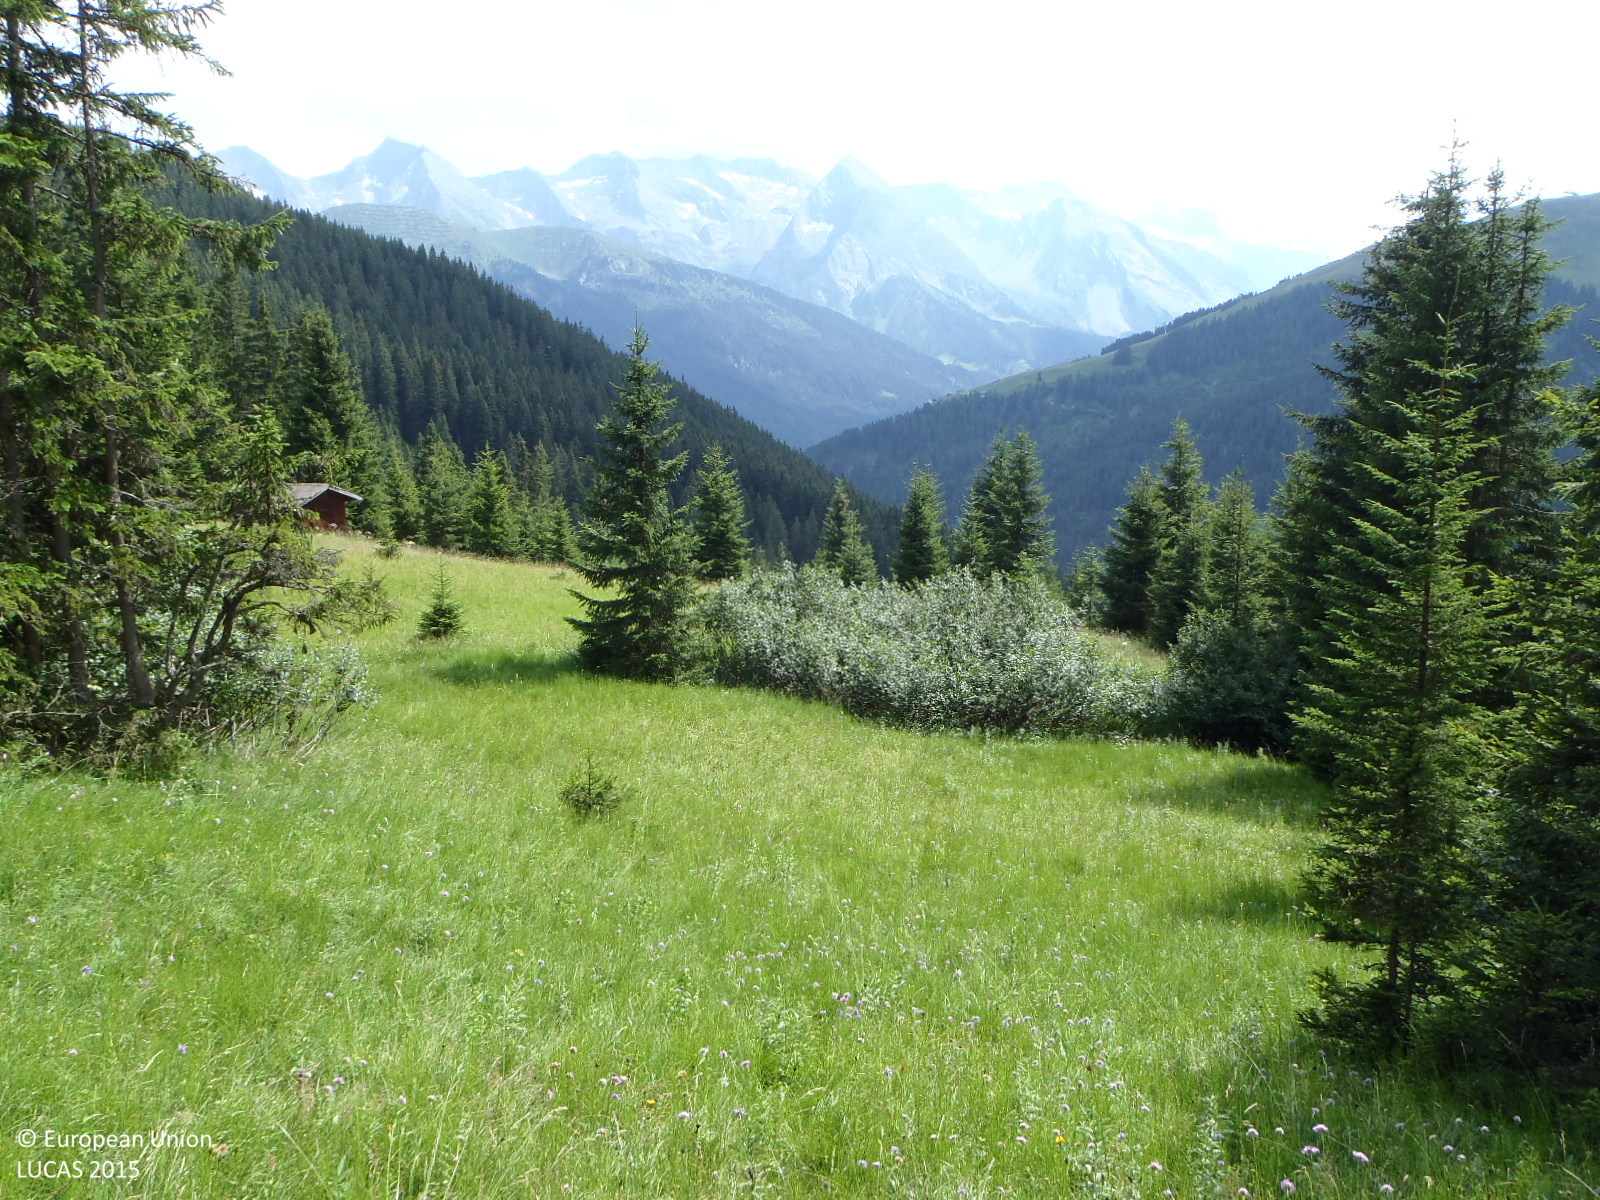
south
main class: Grassland
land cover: Grassland without tree/shrub cover
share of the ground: > 75 %
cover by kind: herbaceous plants 100 %
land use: Agriculture (excluding fallow land and kitchen gardens)
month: July
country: AT
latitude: 47.1838
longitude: 11.7272
